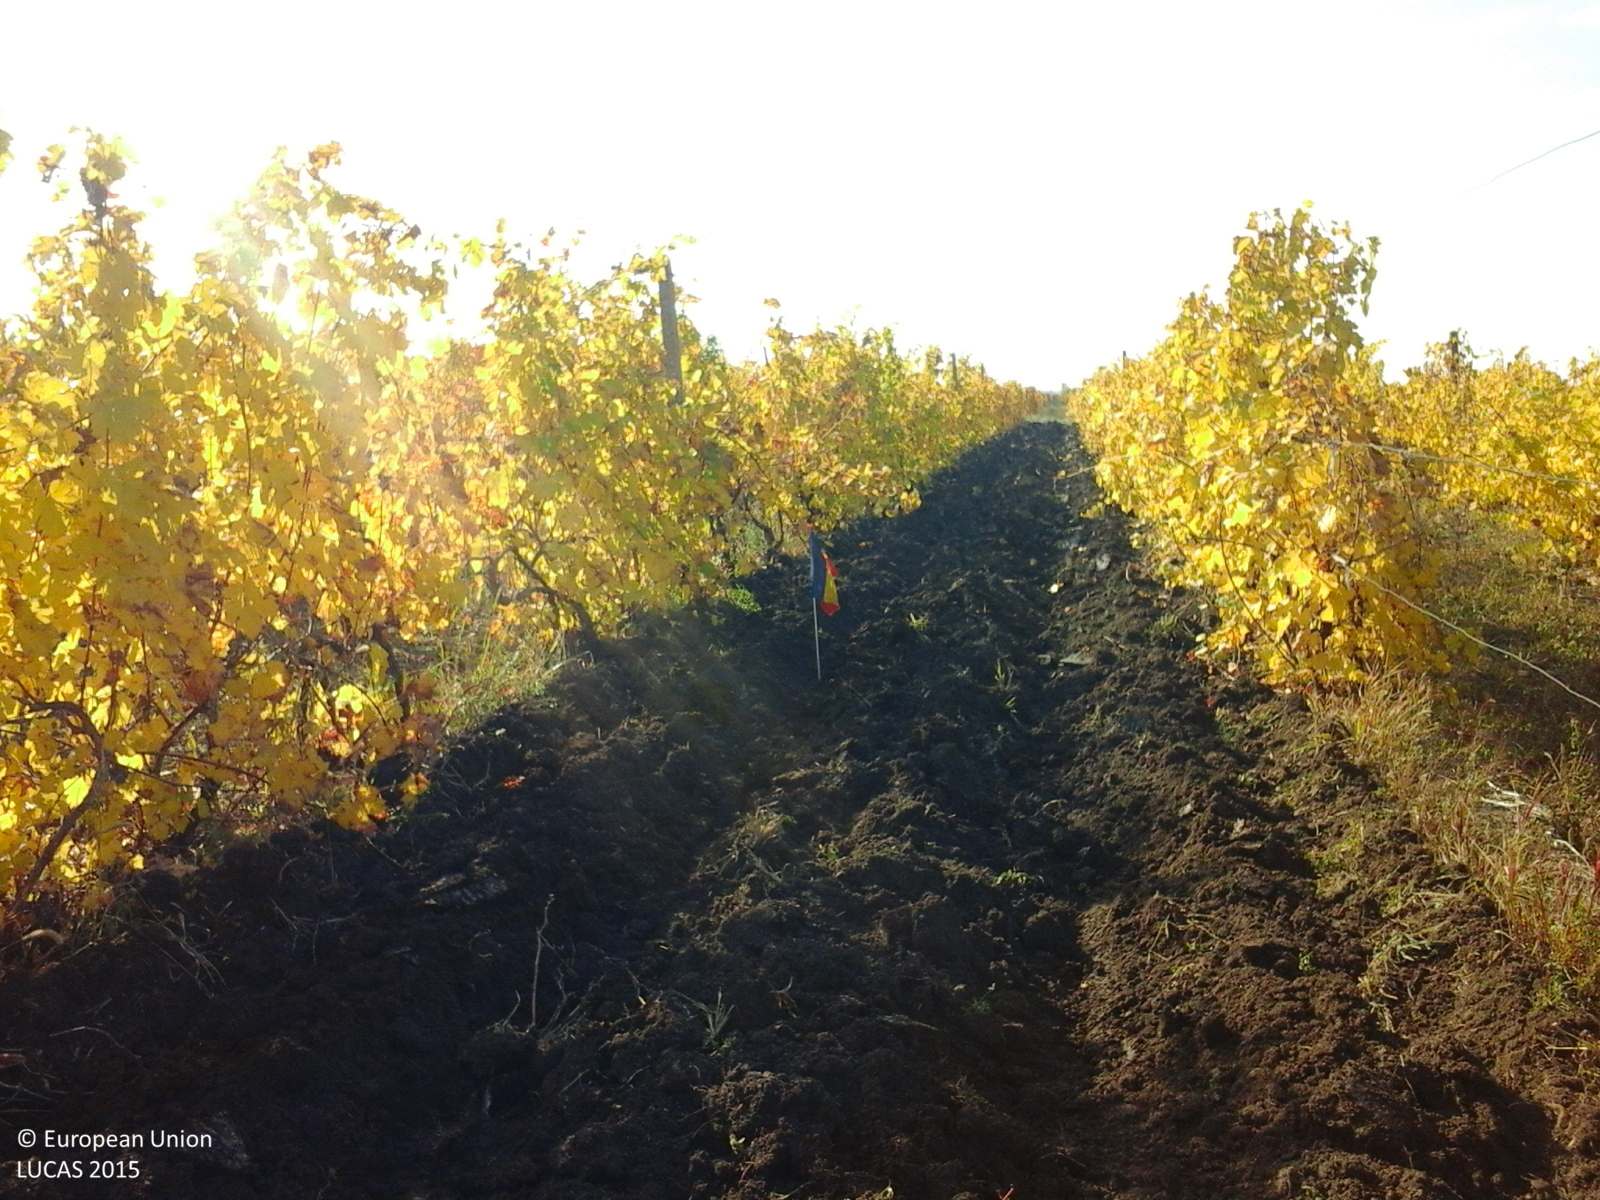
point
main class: Cropland
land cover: Vineyards
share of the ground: > 75 %
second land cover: Other bare soil
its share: > 75 %
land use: Agriculture (excluding fallow land and kitchen gardens)
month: October
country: RO
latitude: 45.5824
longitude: 27.1251
